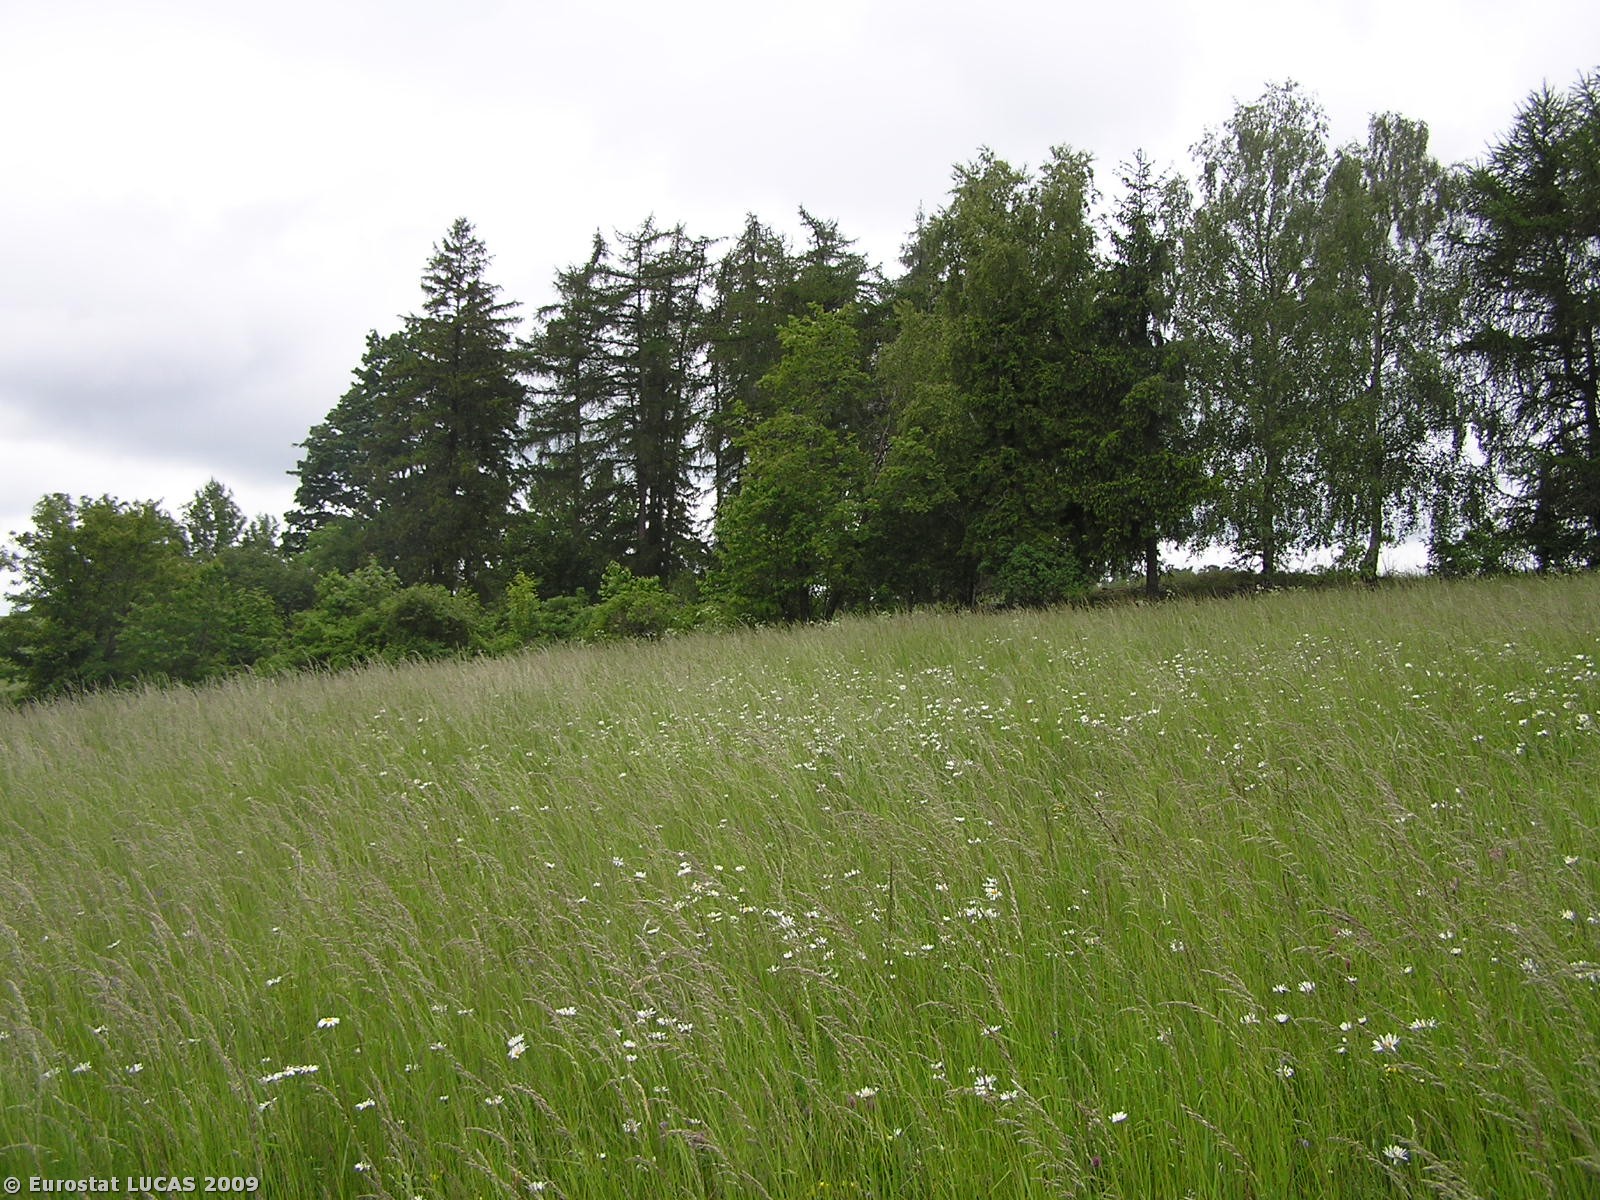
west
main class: Grassland
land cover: Grassland without tree/shrub cover
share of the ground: > 75 %
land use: Agriculture (excluding fallow land and kitchen gardens)
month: June
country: CZ
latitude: 50.0502
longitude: 17.4278
